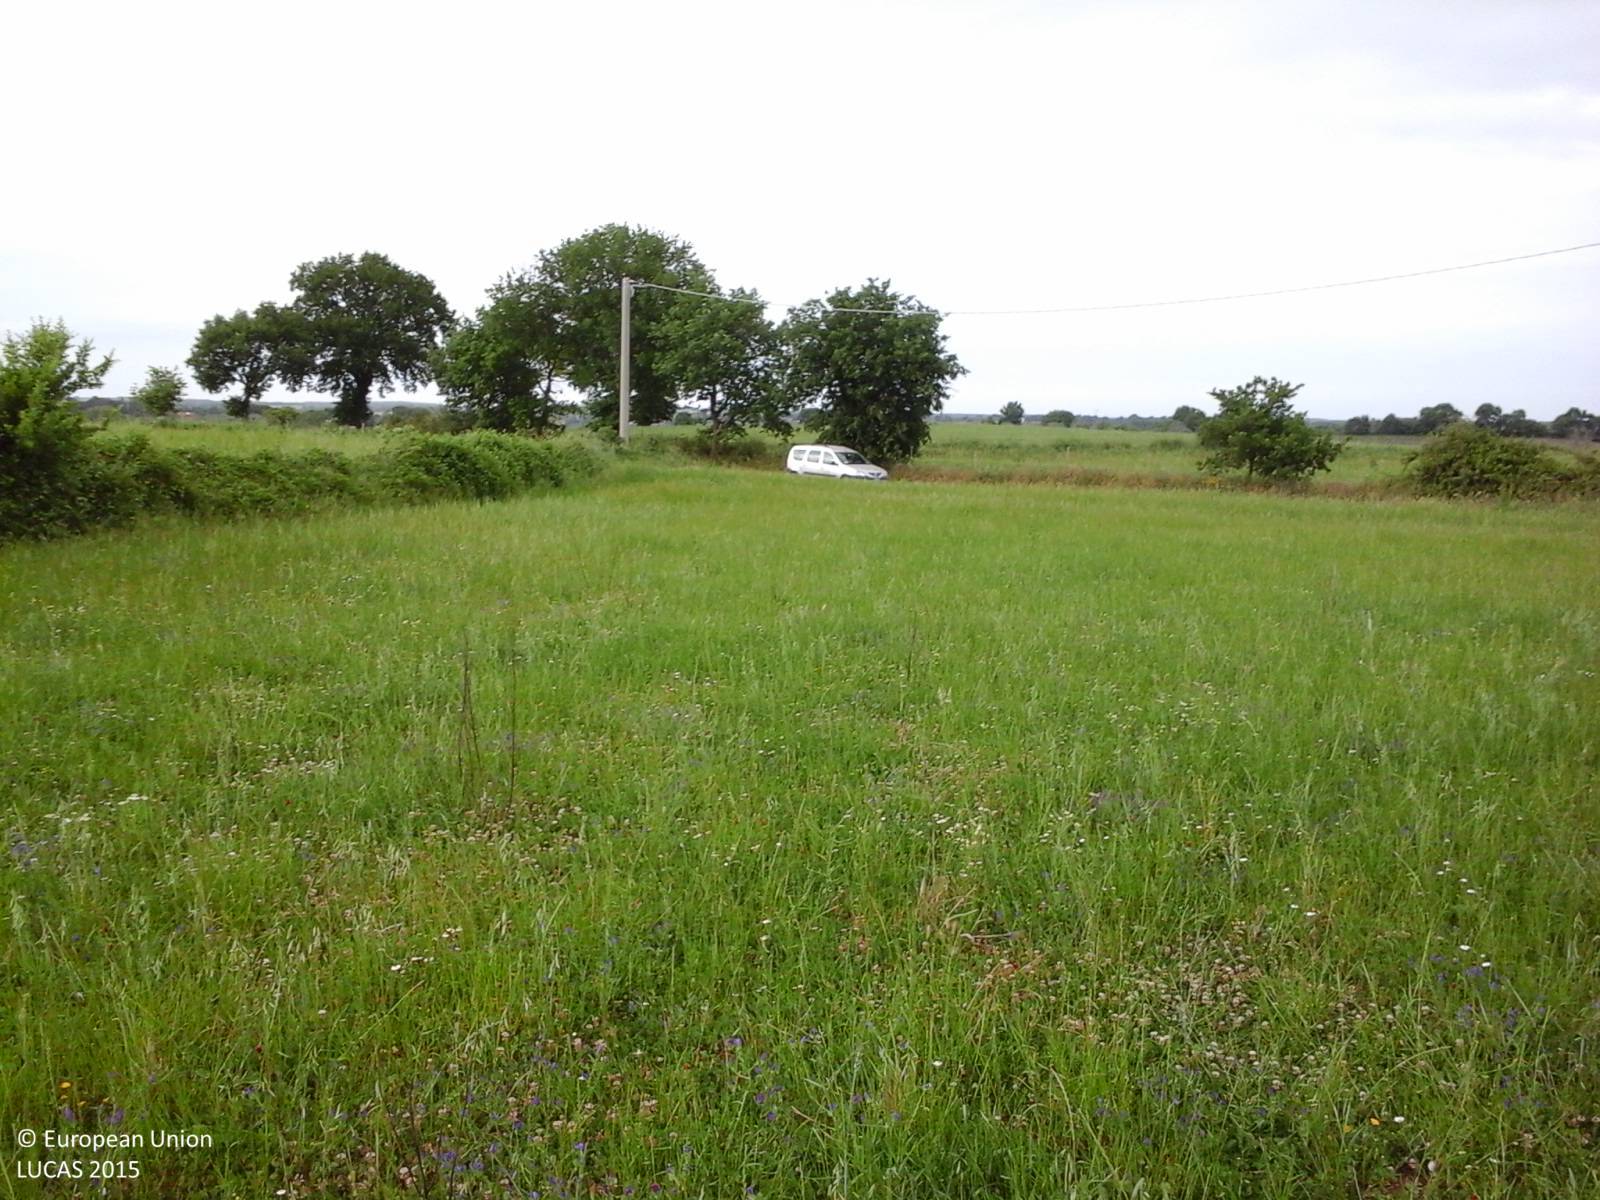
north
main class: Cropland
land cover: Other leguminous and mixtures for fodder
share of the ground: > 75 %
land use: Agriculture (excluding fallow land and kitchen gardens)
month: May
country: IT
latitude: 42.5239
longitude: 12.0989
